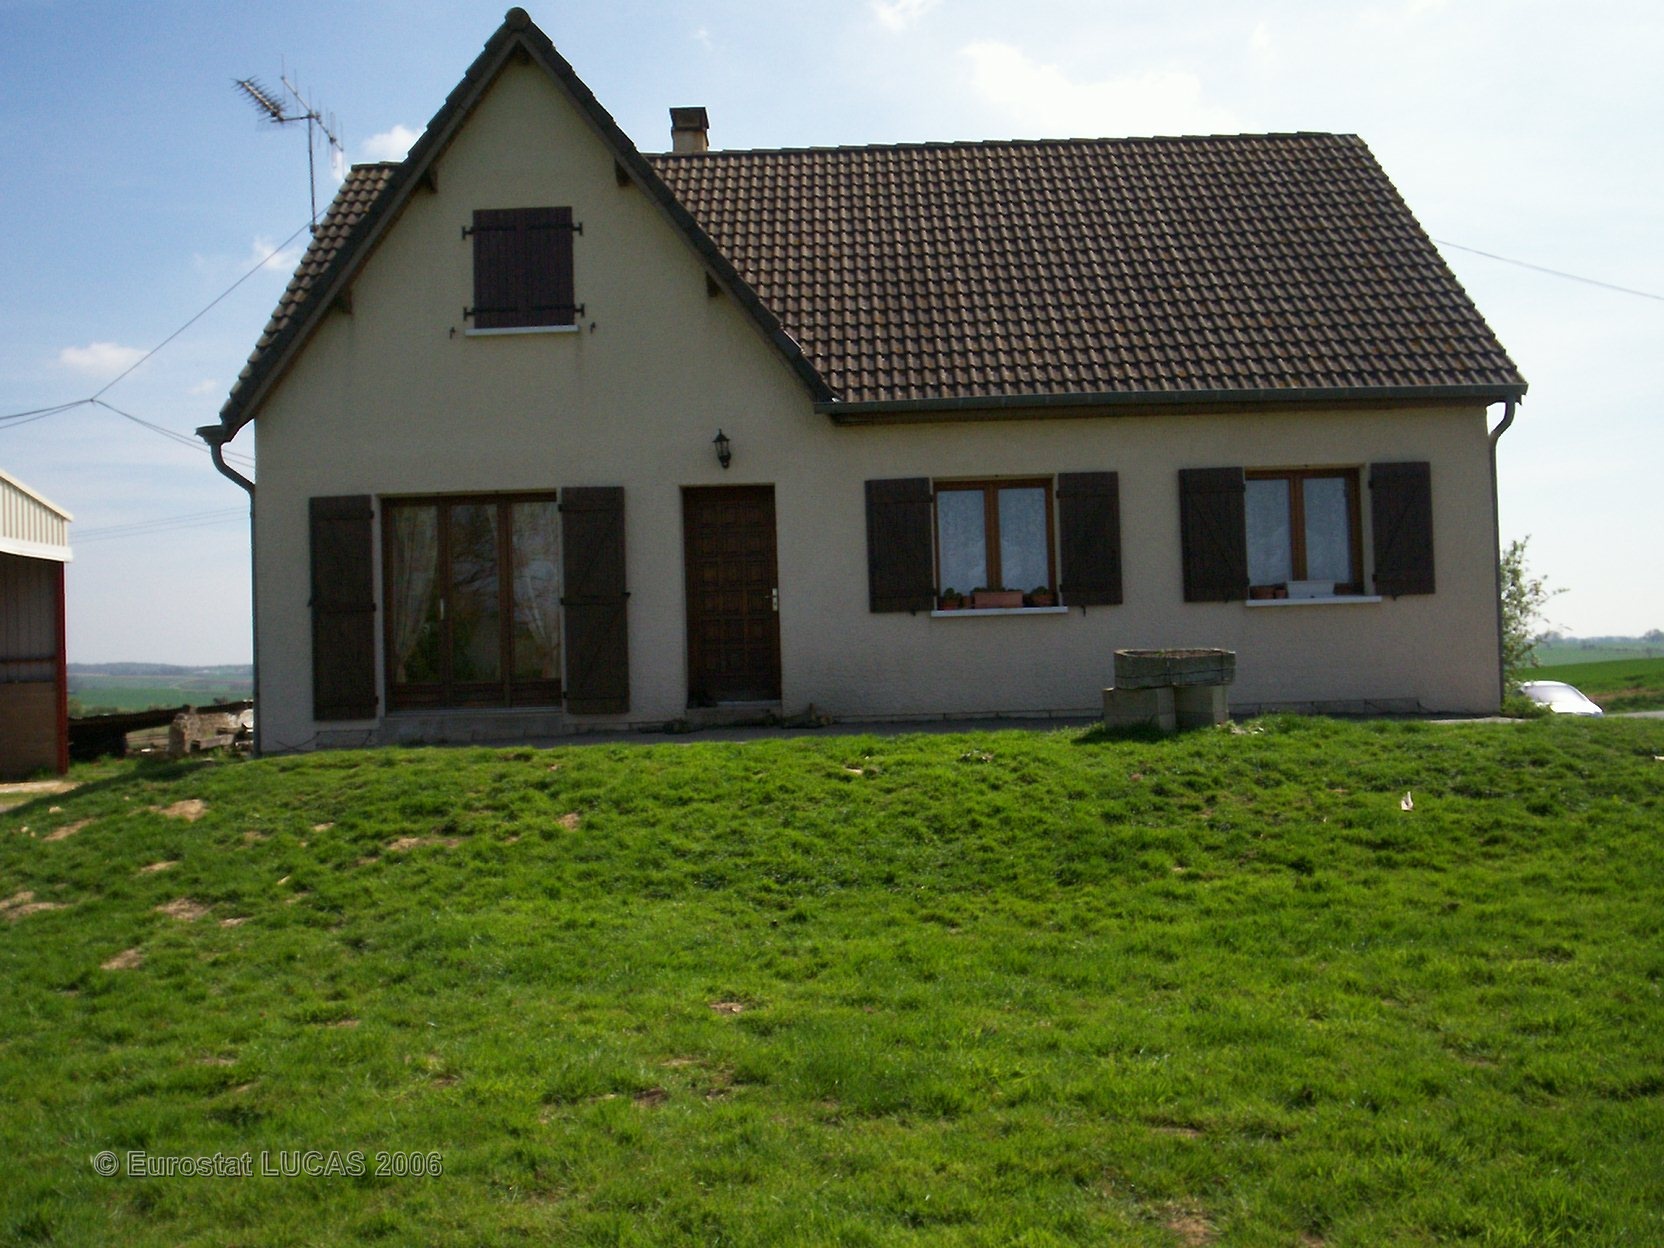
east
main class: Grassland
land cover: Grassland with sparse tree/shrub cover
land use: Residential
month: April
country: FR
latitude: 49.6328
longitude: 4.4162
